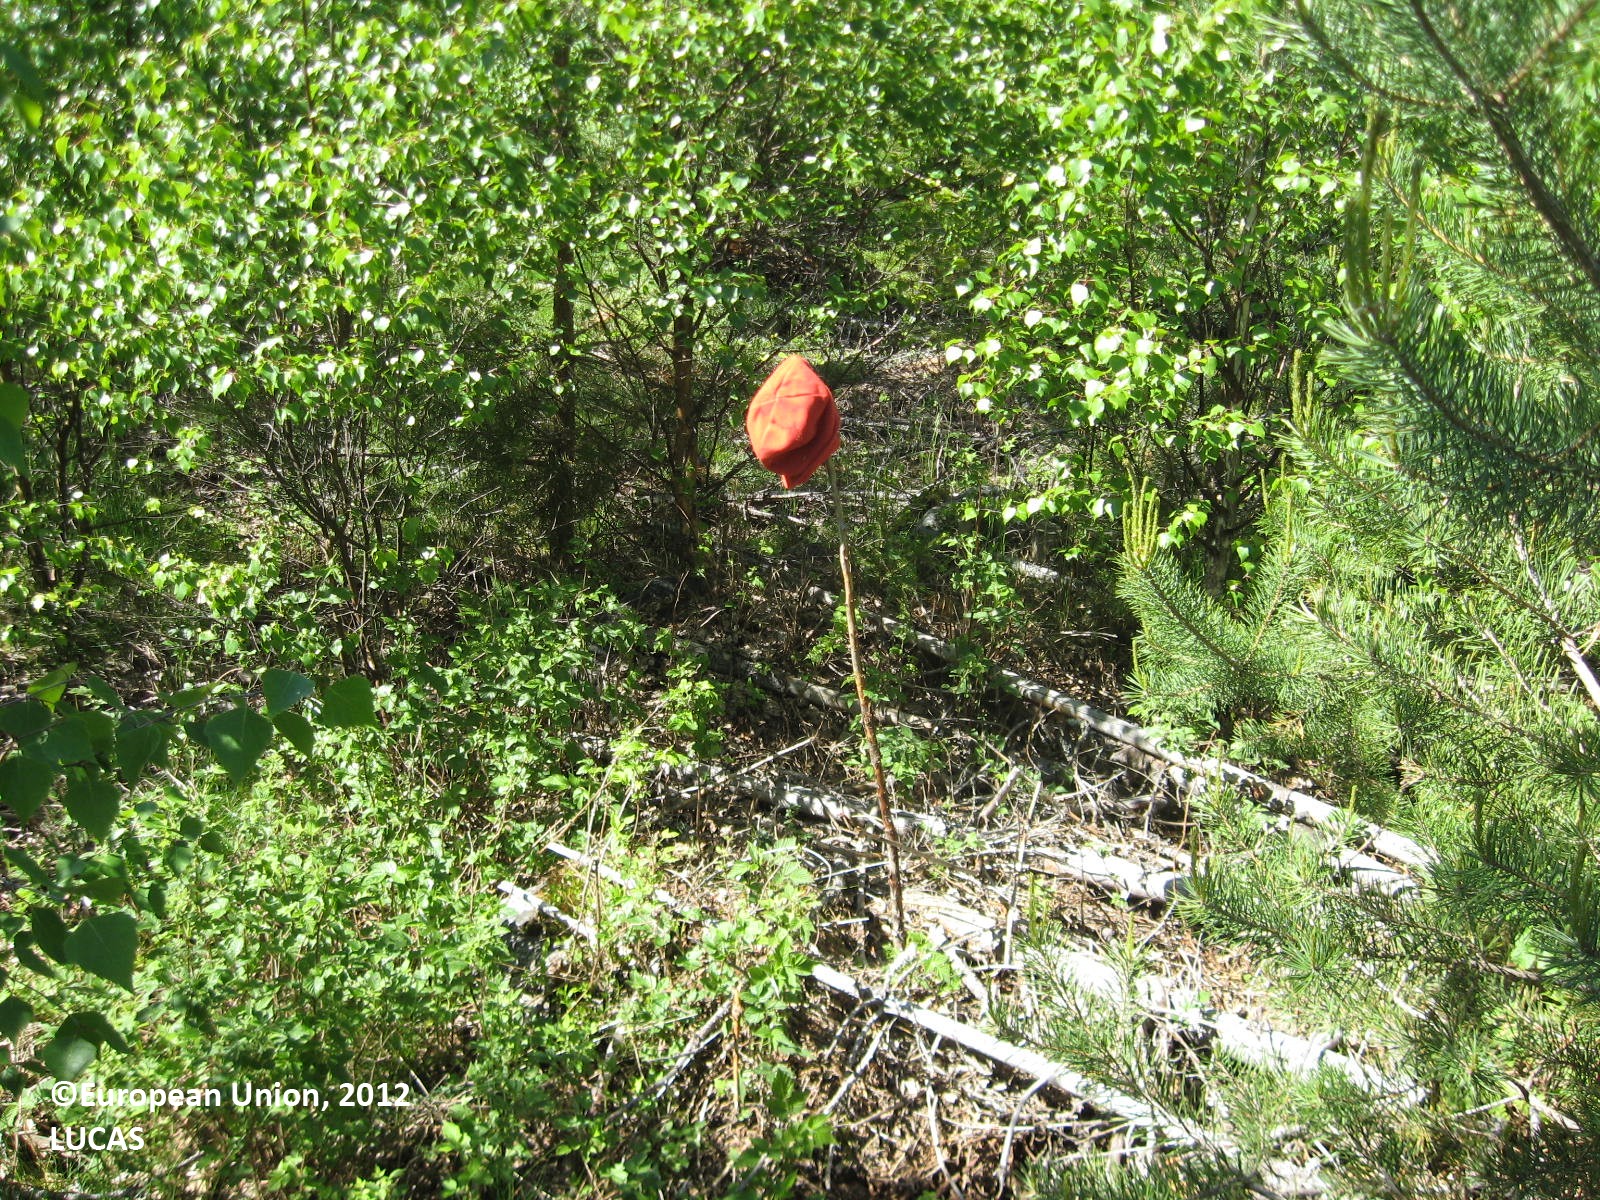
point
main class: Woodland
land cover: Pine dominated mixed woodland
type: boreal forest
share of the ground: > 75 %
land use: Forestry
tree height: < 5 m
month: June
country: FI
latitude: 62.7987
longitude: 21.1558
